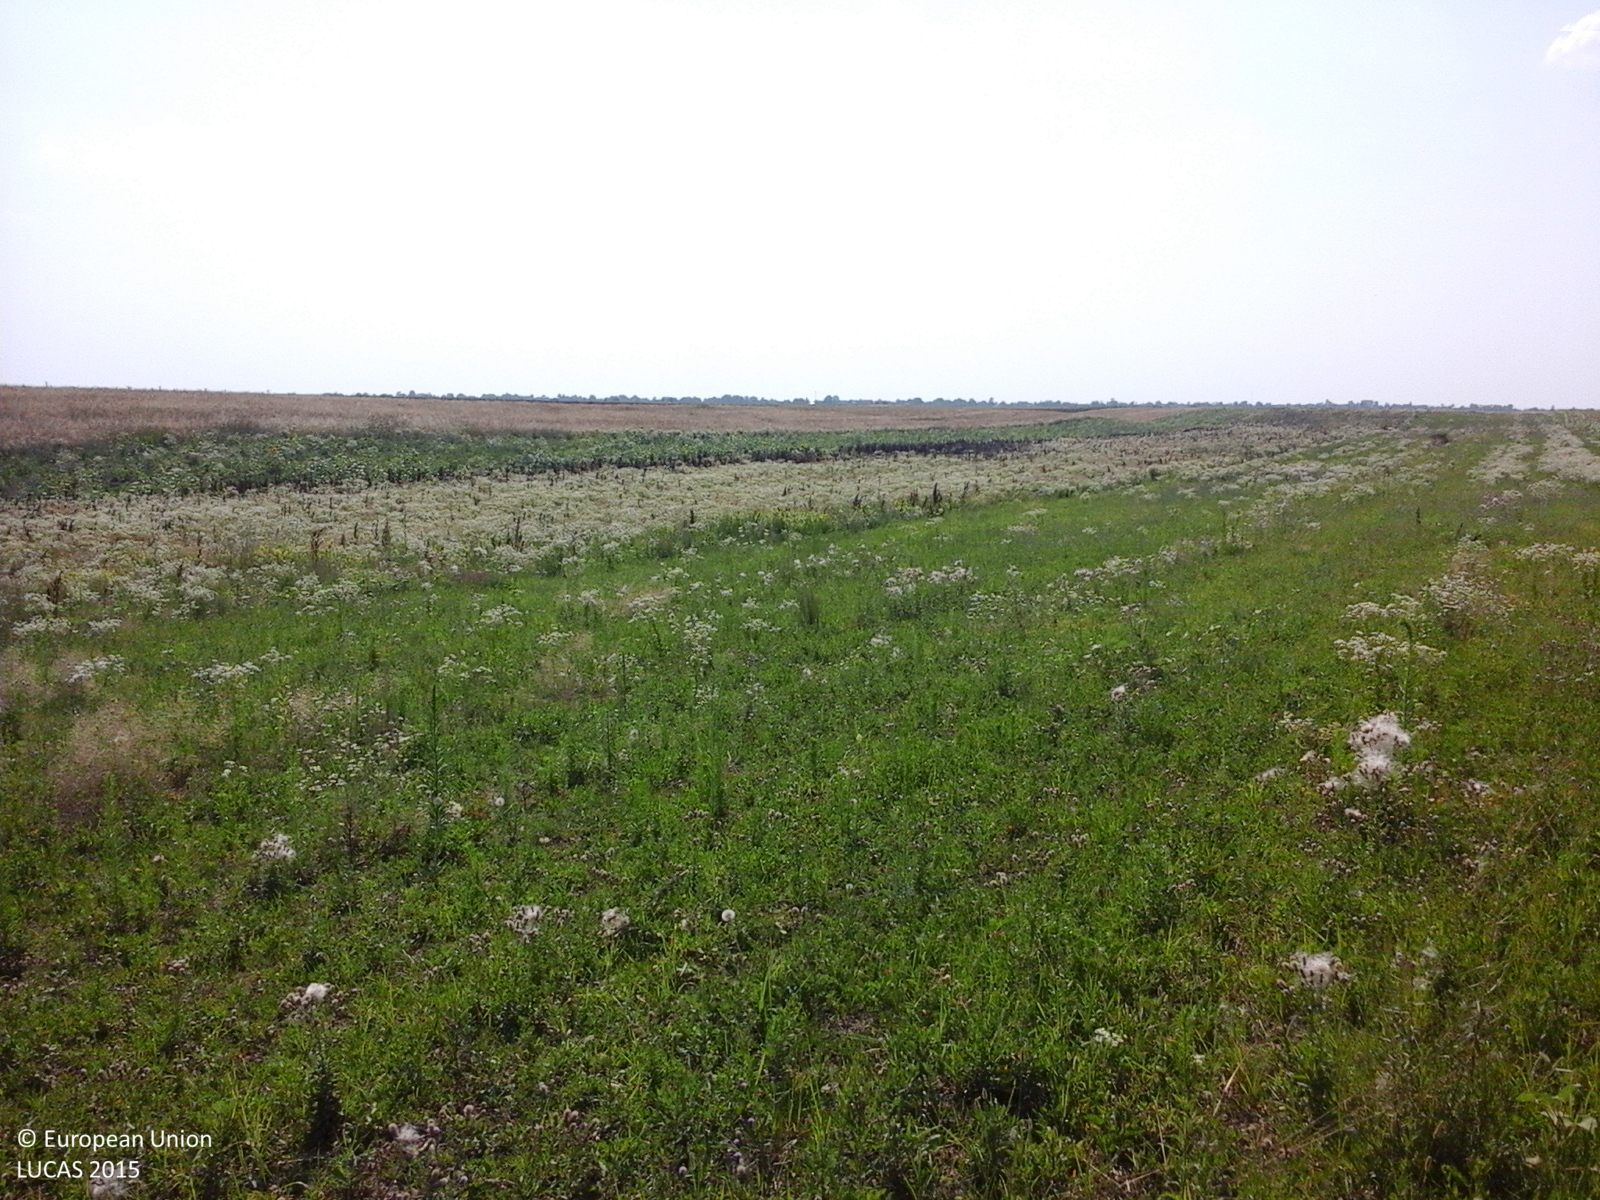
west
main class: Grassland
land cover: Spontaneously vegetated surfaces
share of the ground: > 75 %
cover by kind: herbaceous plants 100 %
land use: Fallow land
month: July
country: RO
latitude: 44.5907
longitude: 25.3693
